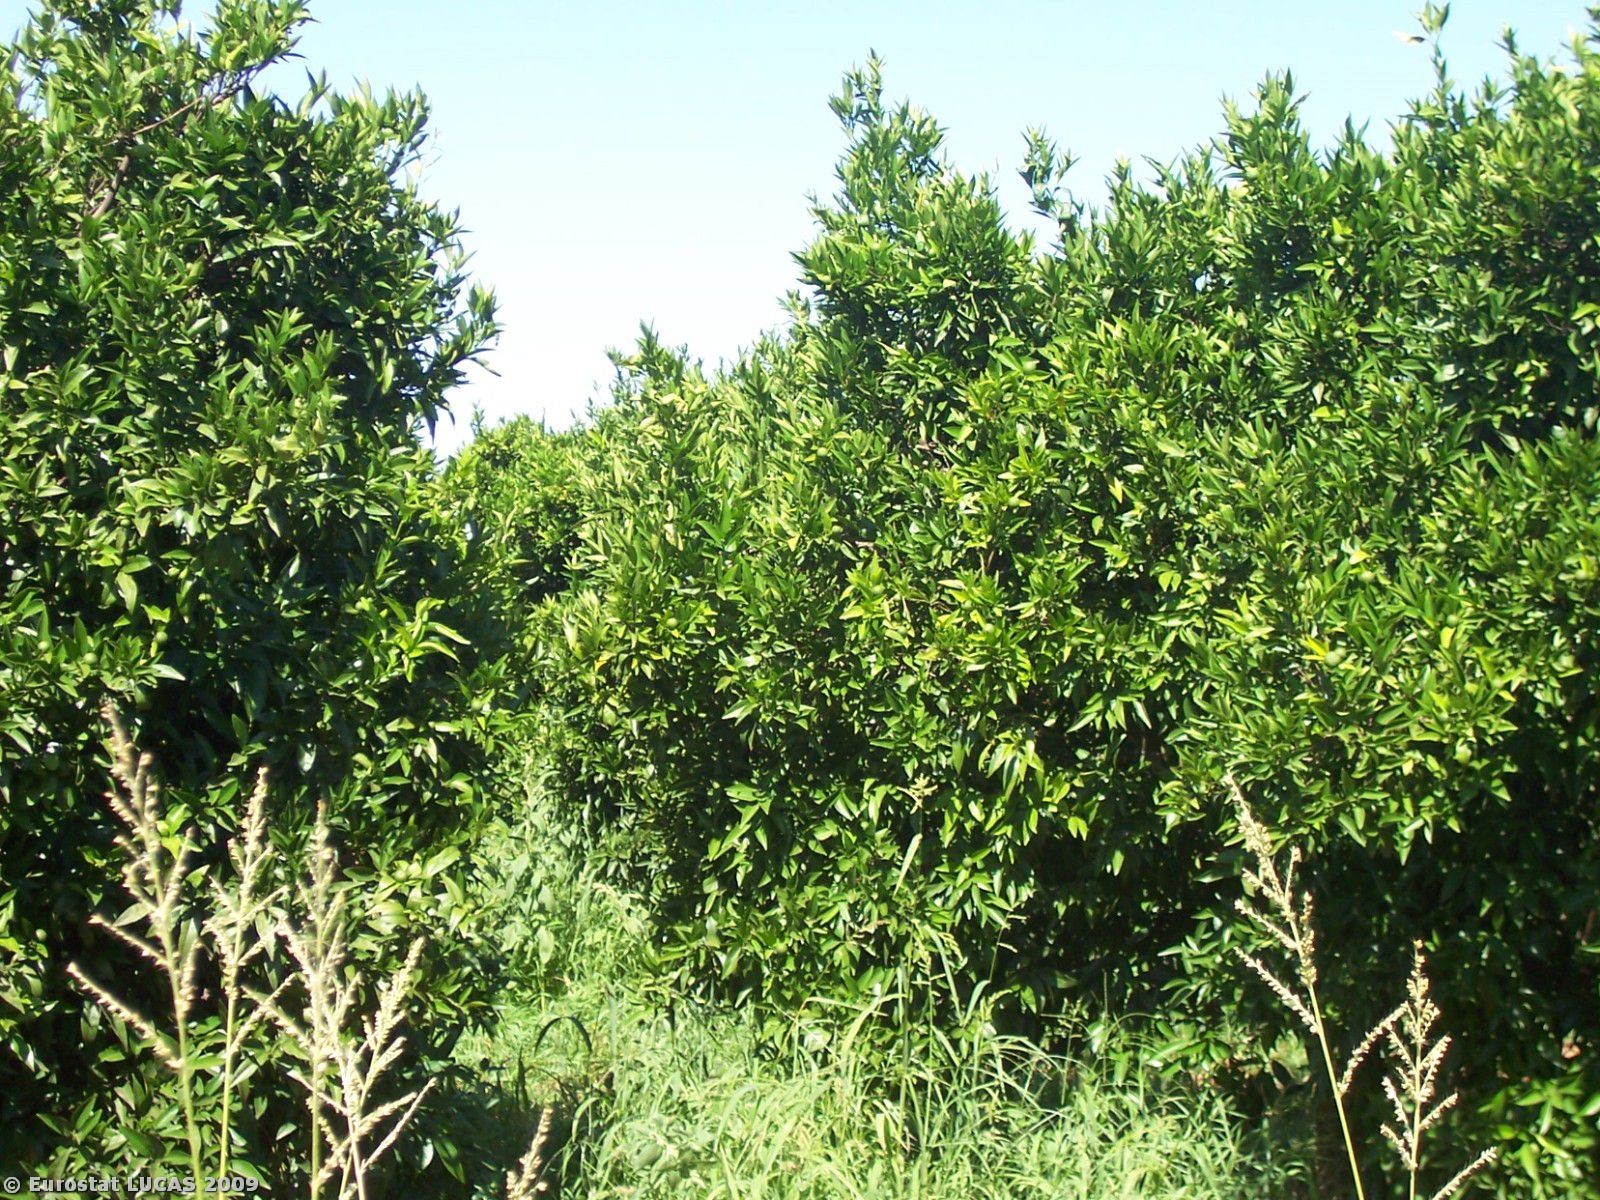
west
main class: Cropland
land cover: Other citrus fruit
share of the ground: 50 - 75 %
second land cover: Spontaneously vegetated surfaces
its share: > 75 %
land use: Agriculture (excluding fallow land and kitchen gardens)
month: July
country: IT
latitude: 40.5795
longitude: 17.0054
